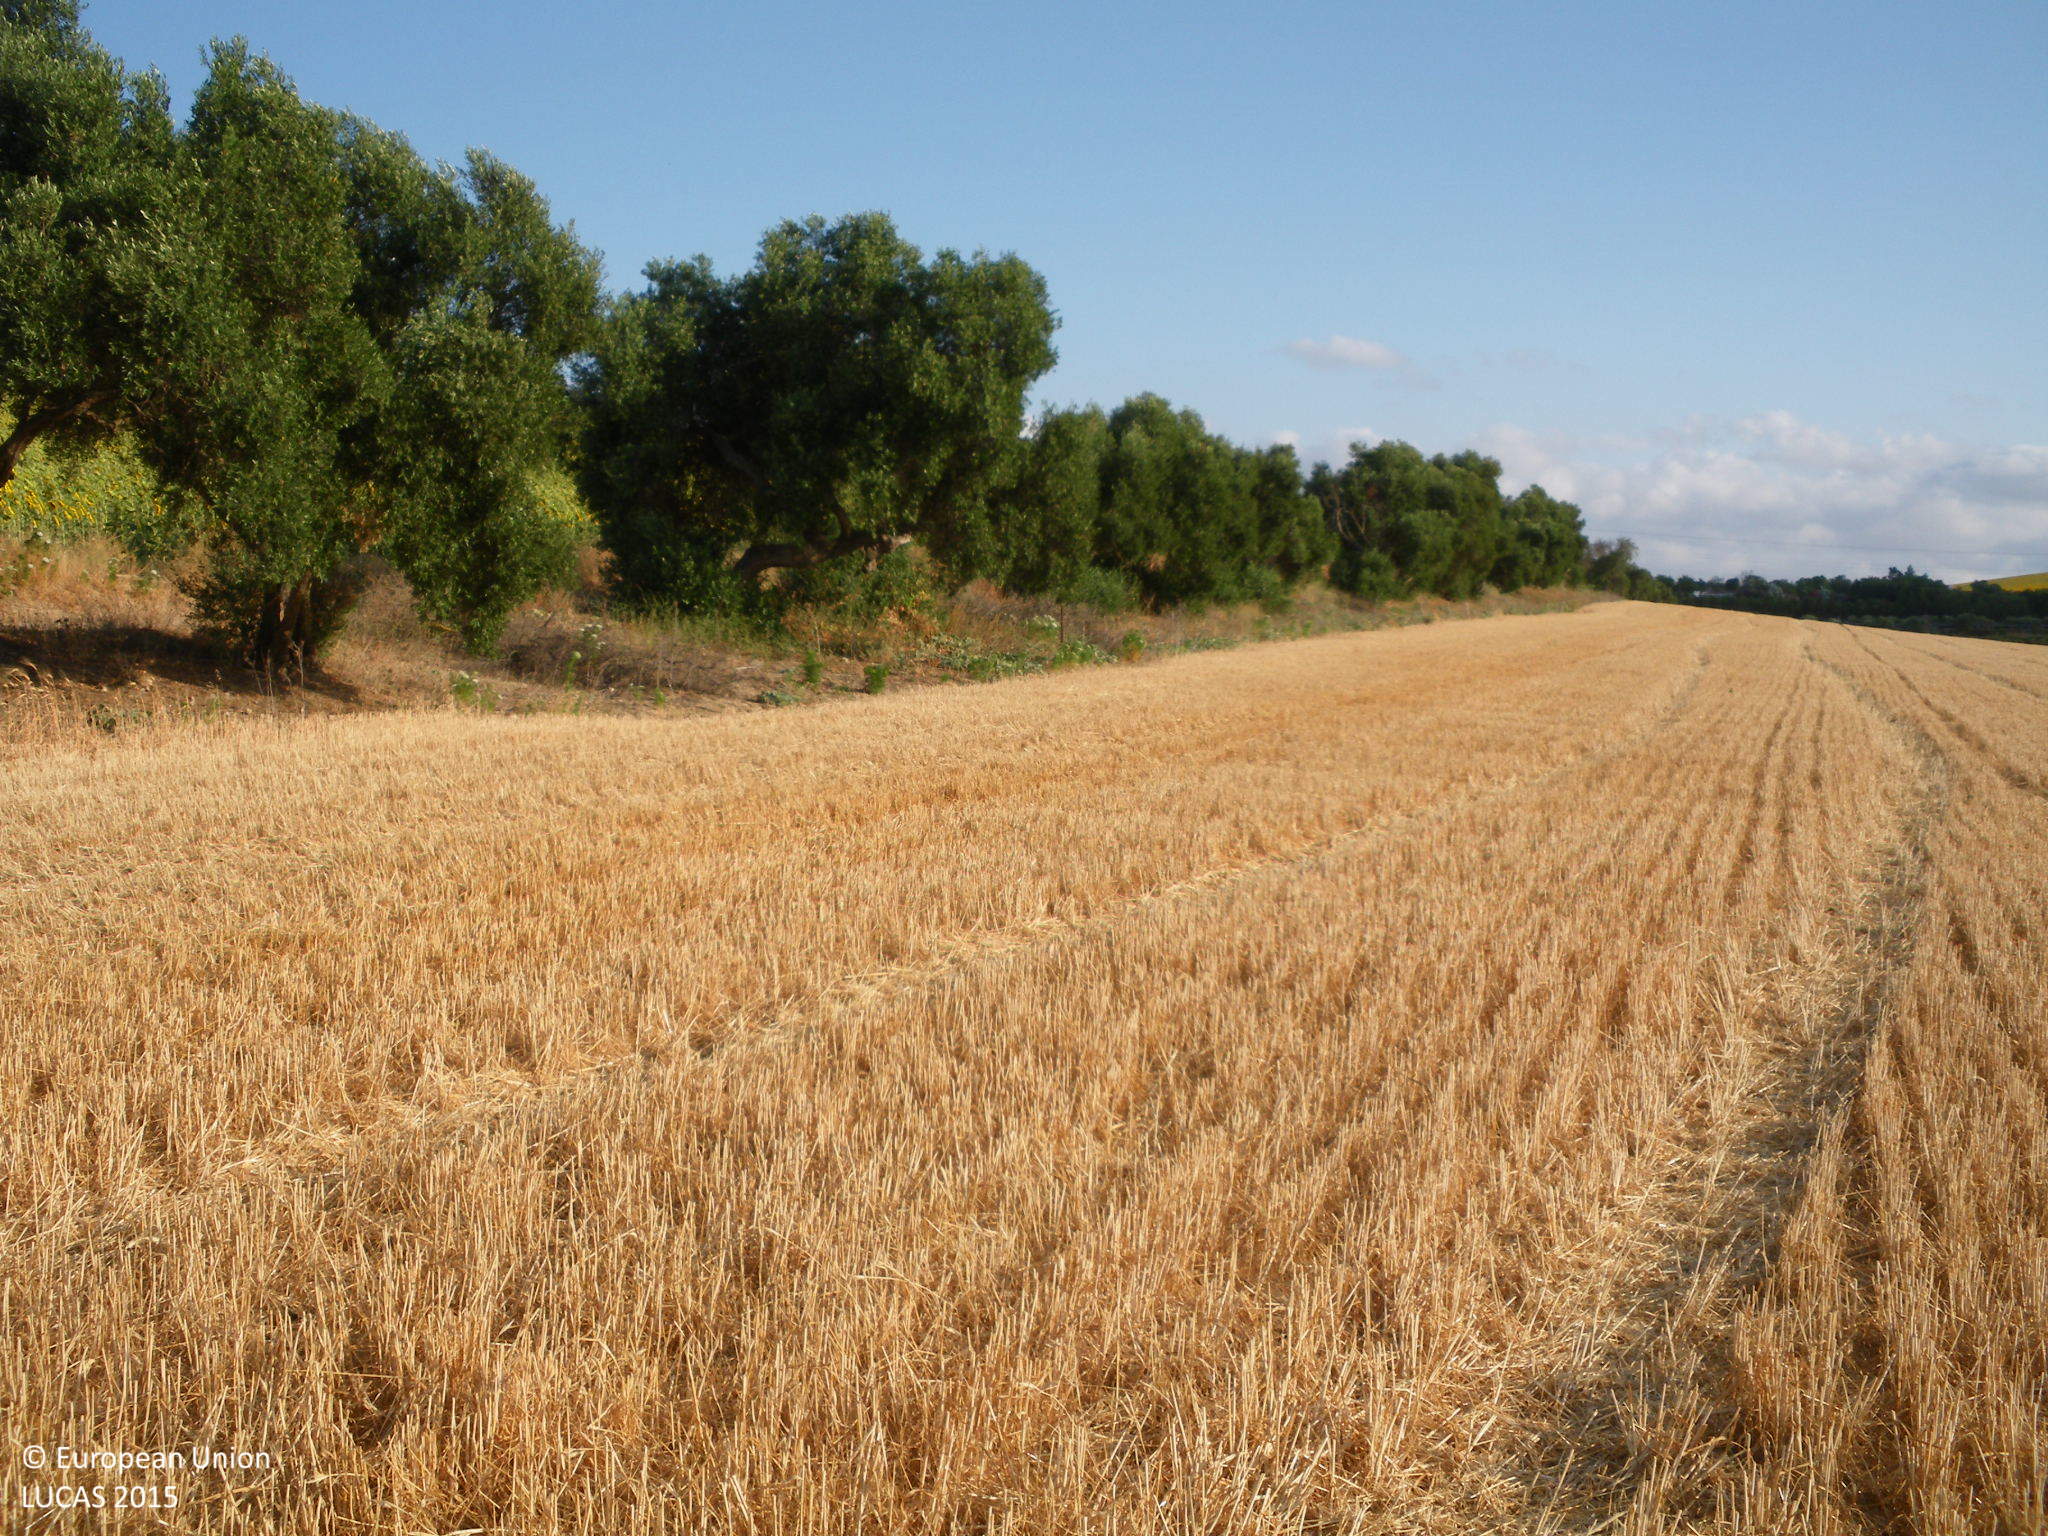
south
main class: Cropland
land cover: Durum wheat
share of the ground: < 10 %
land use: Agriculture (excluding fallow land and kitchen gardens)
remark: Harvested field
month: June
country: ES
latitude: 36.7175
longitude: -5.9868
